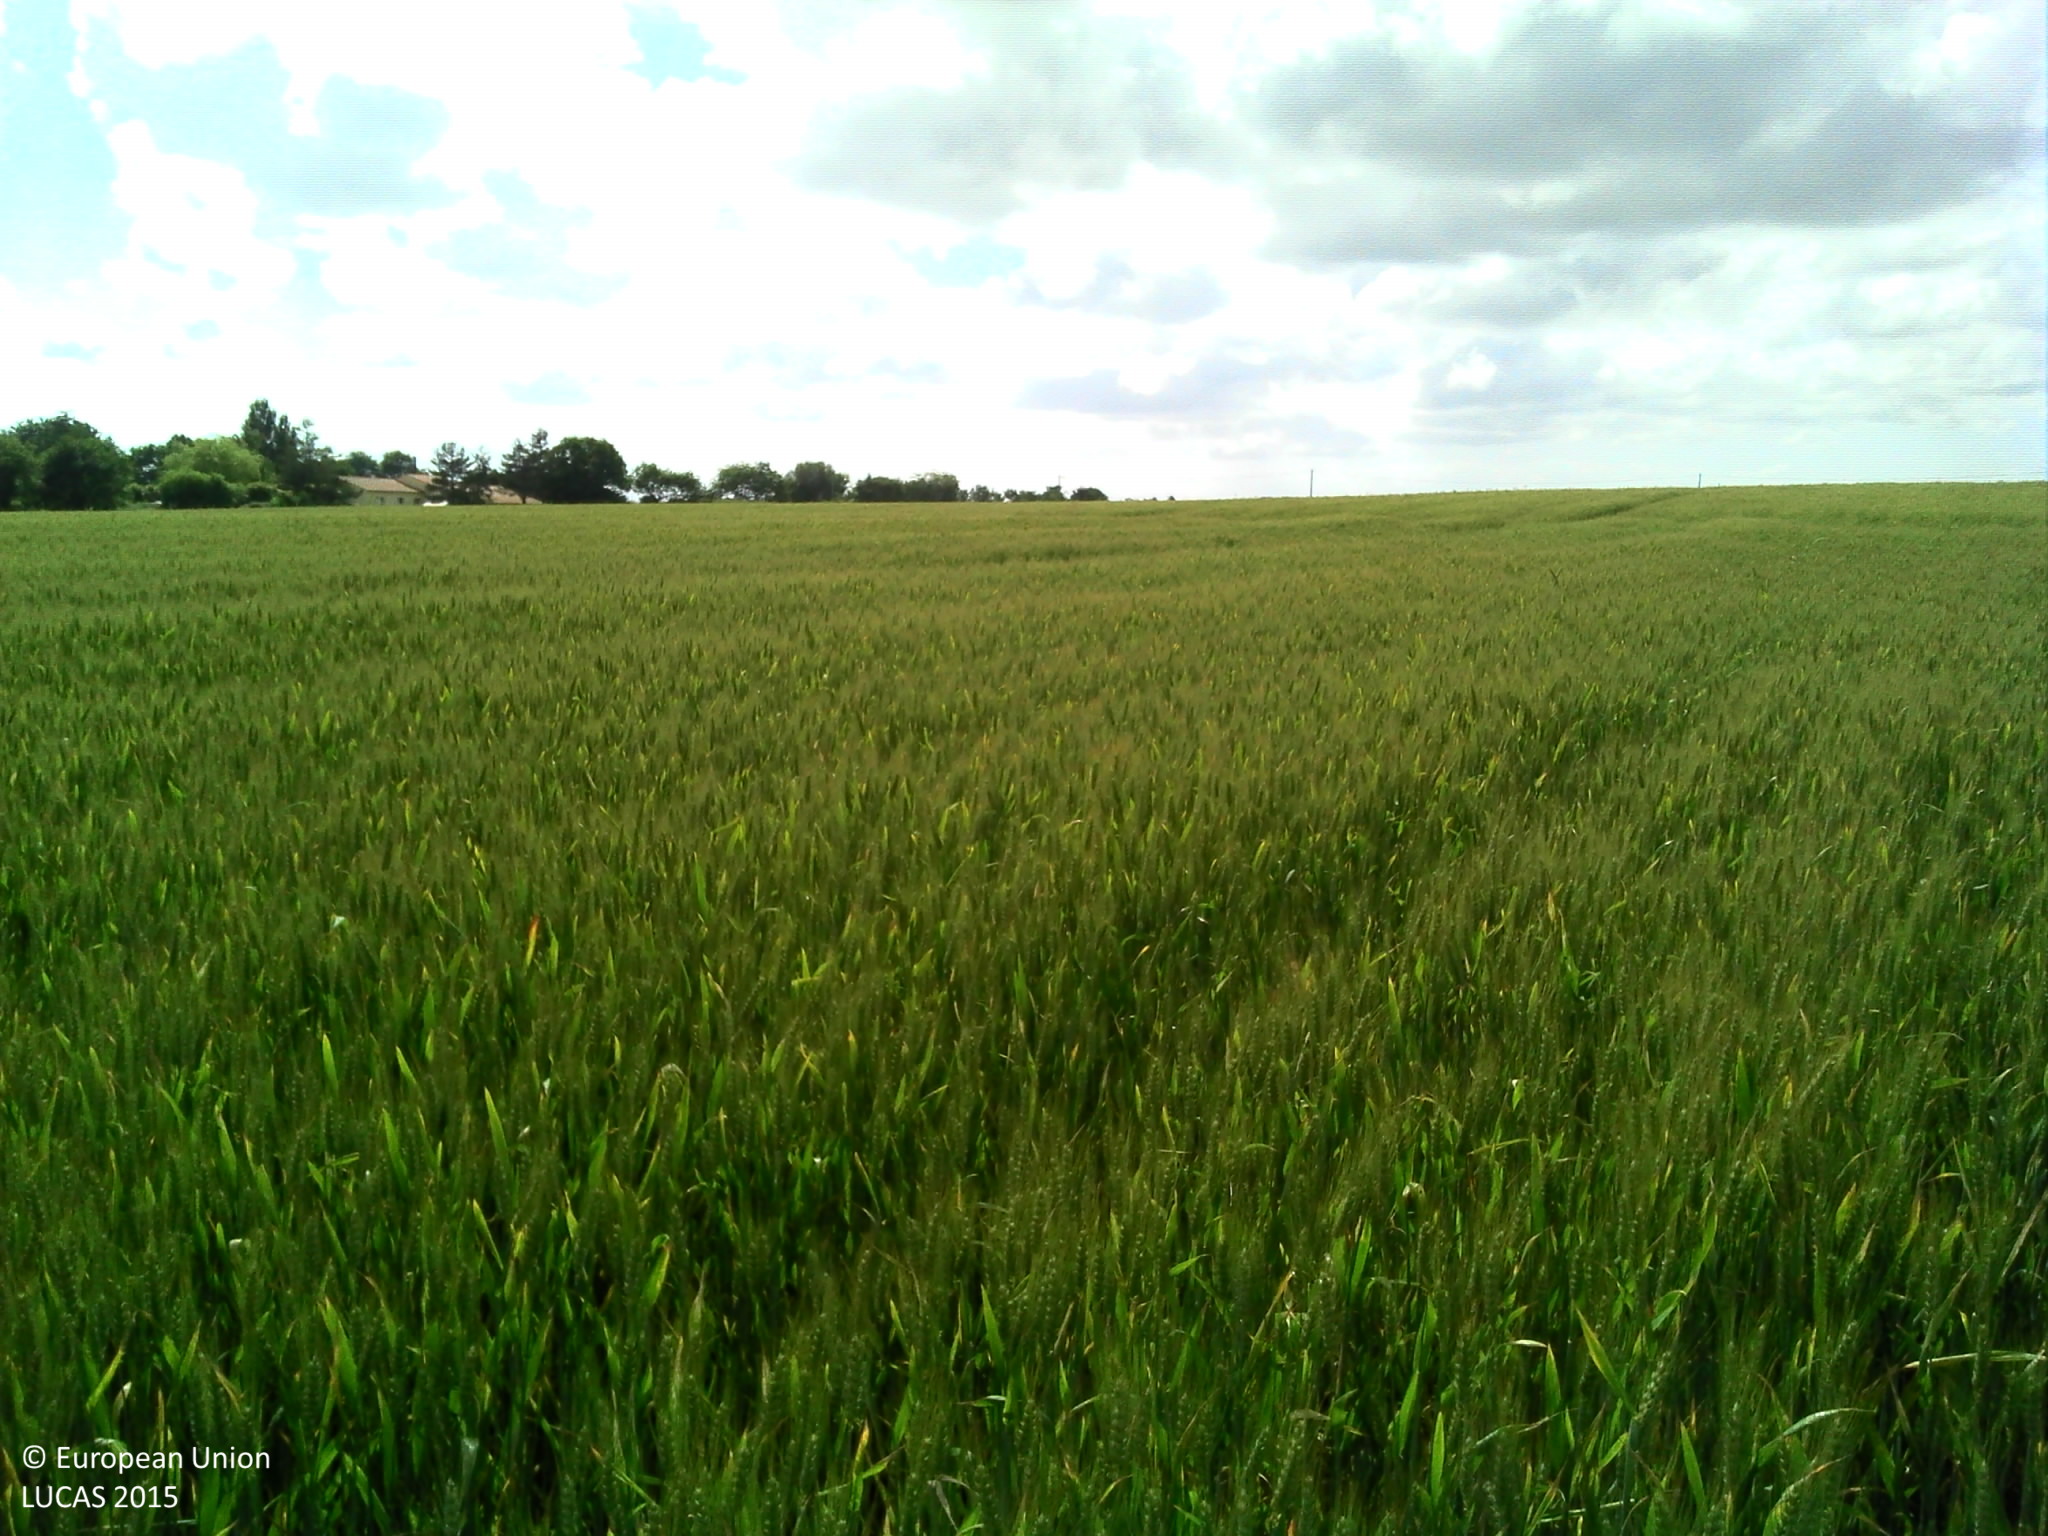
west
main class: Cropland
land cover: Common wheat
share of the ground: > 75 %
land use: Agriculture (excluding fallow land and kitchen gardens)
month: June
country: FR
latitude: 46.8737
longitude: -1.8393
